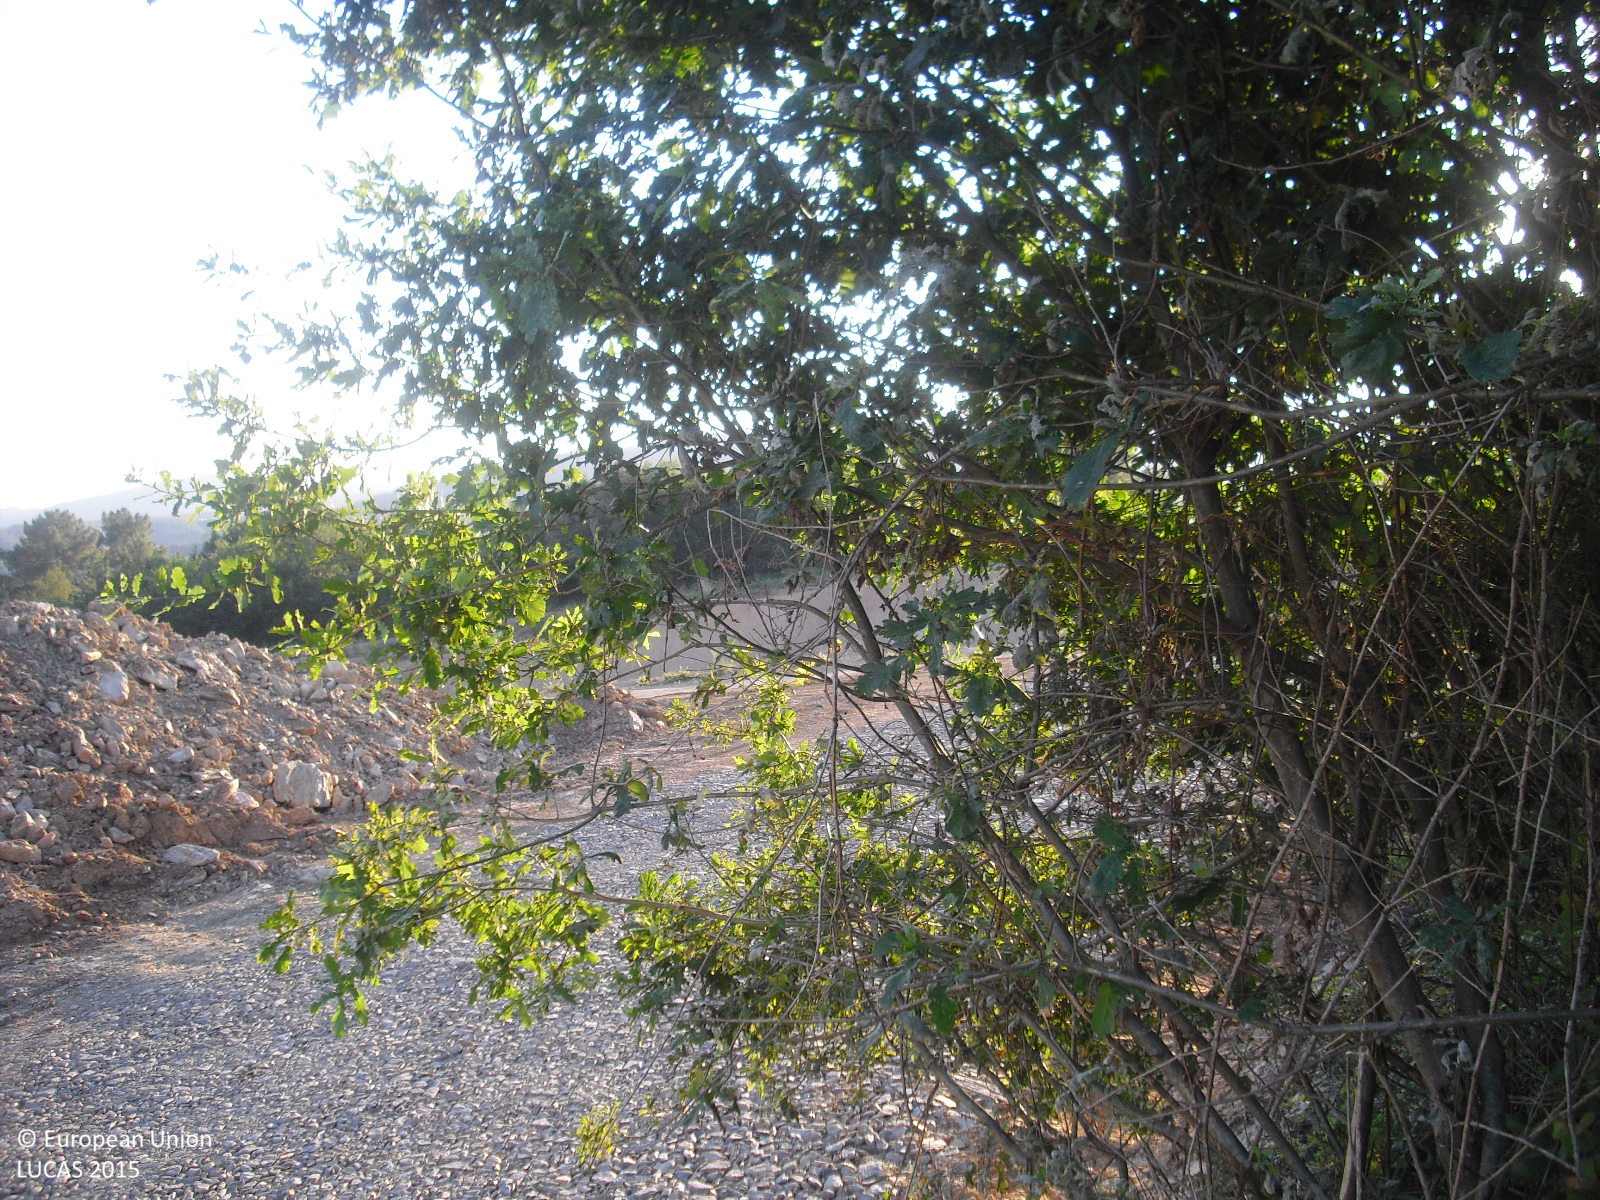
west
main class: Woodland
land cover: Broadleaved woodland
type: acidophilous oak and oak-birch forest
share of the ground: 25 - 50 %
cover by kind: shrubs 55 %, broadleaved forest trees 40 %, coniferous forest trees 5 %
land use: Semi-natural and natural areas not in use
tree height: > 5 m
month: July
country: ES
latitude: 42.6330
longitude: -7.4715
